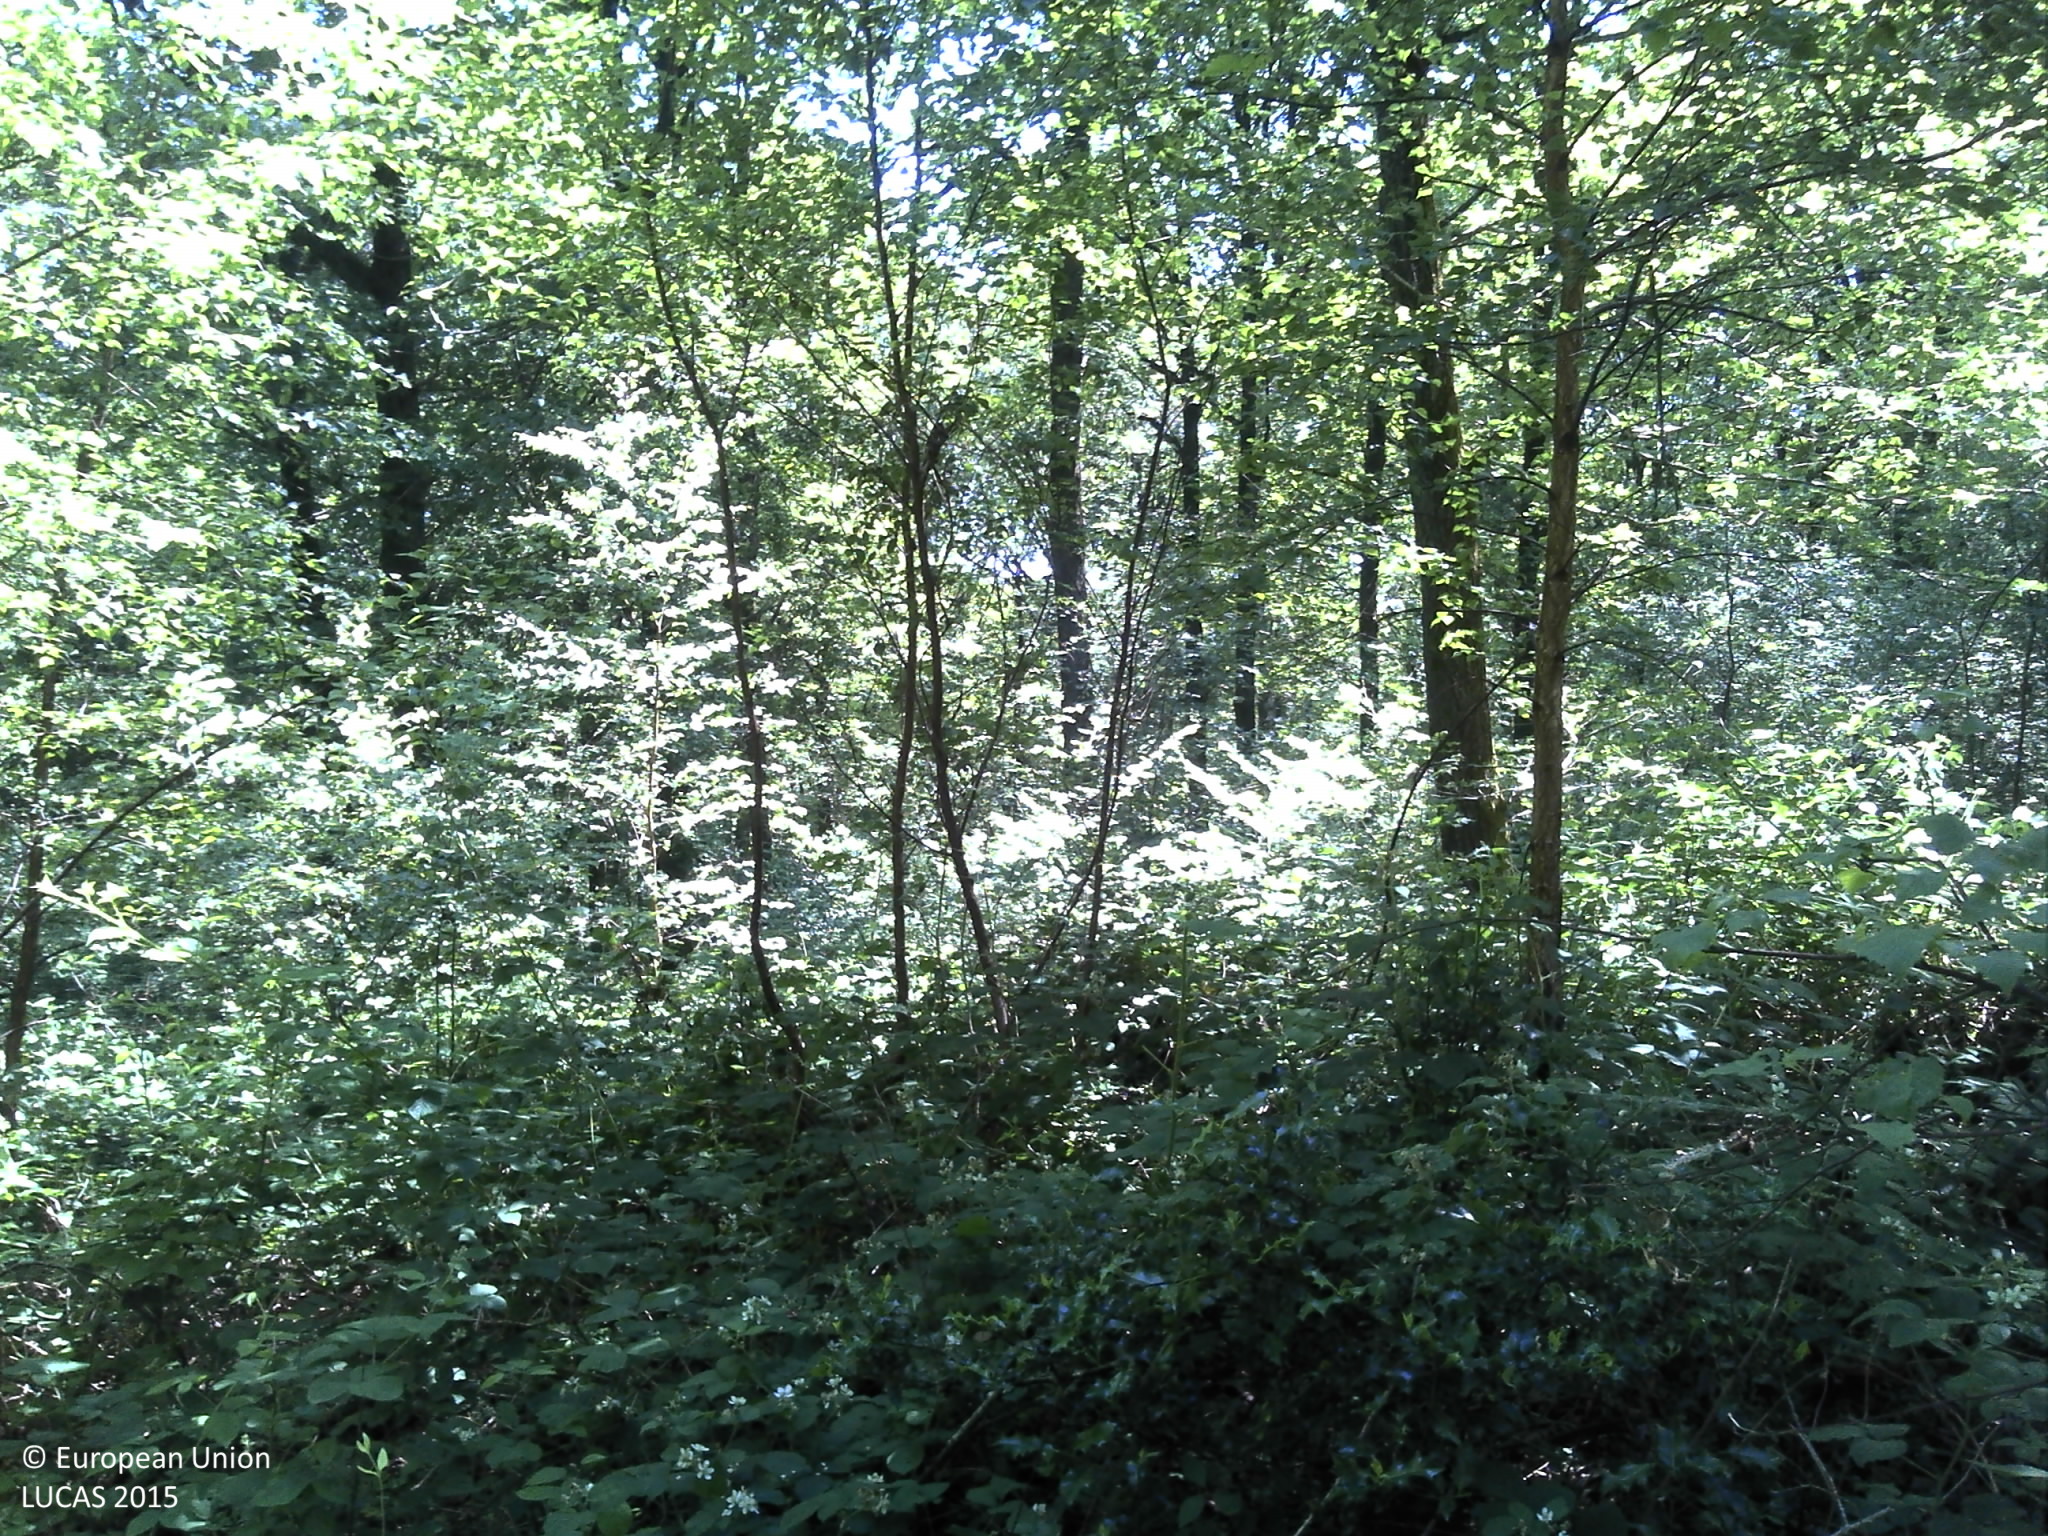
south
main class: Woodland
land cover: Broadleaved woodland
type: acidophilous oak and oak-birch forest
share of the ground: 50 - 75 %
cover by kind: broadleaved forest trees 70 %, herbaceous plants 25 %, consolidated bare surface 5 %
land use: Forestry
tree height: > 5 m
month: June
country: FR
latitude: 50.0842
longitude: 4.8119
